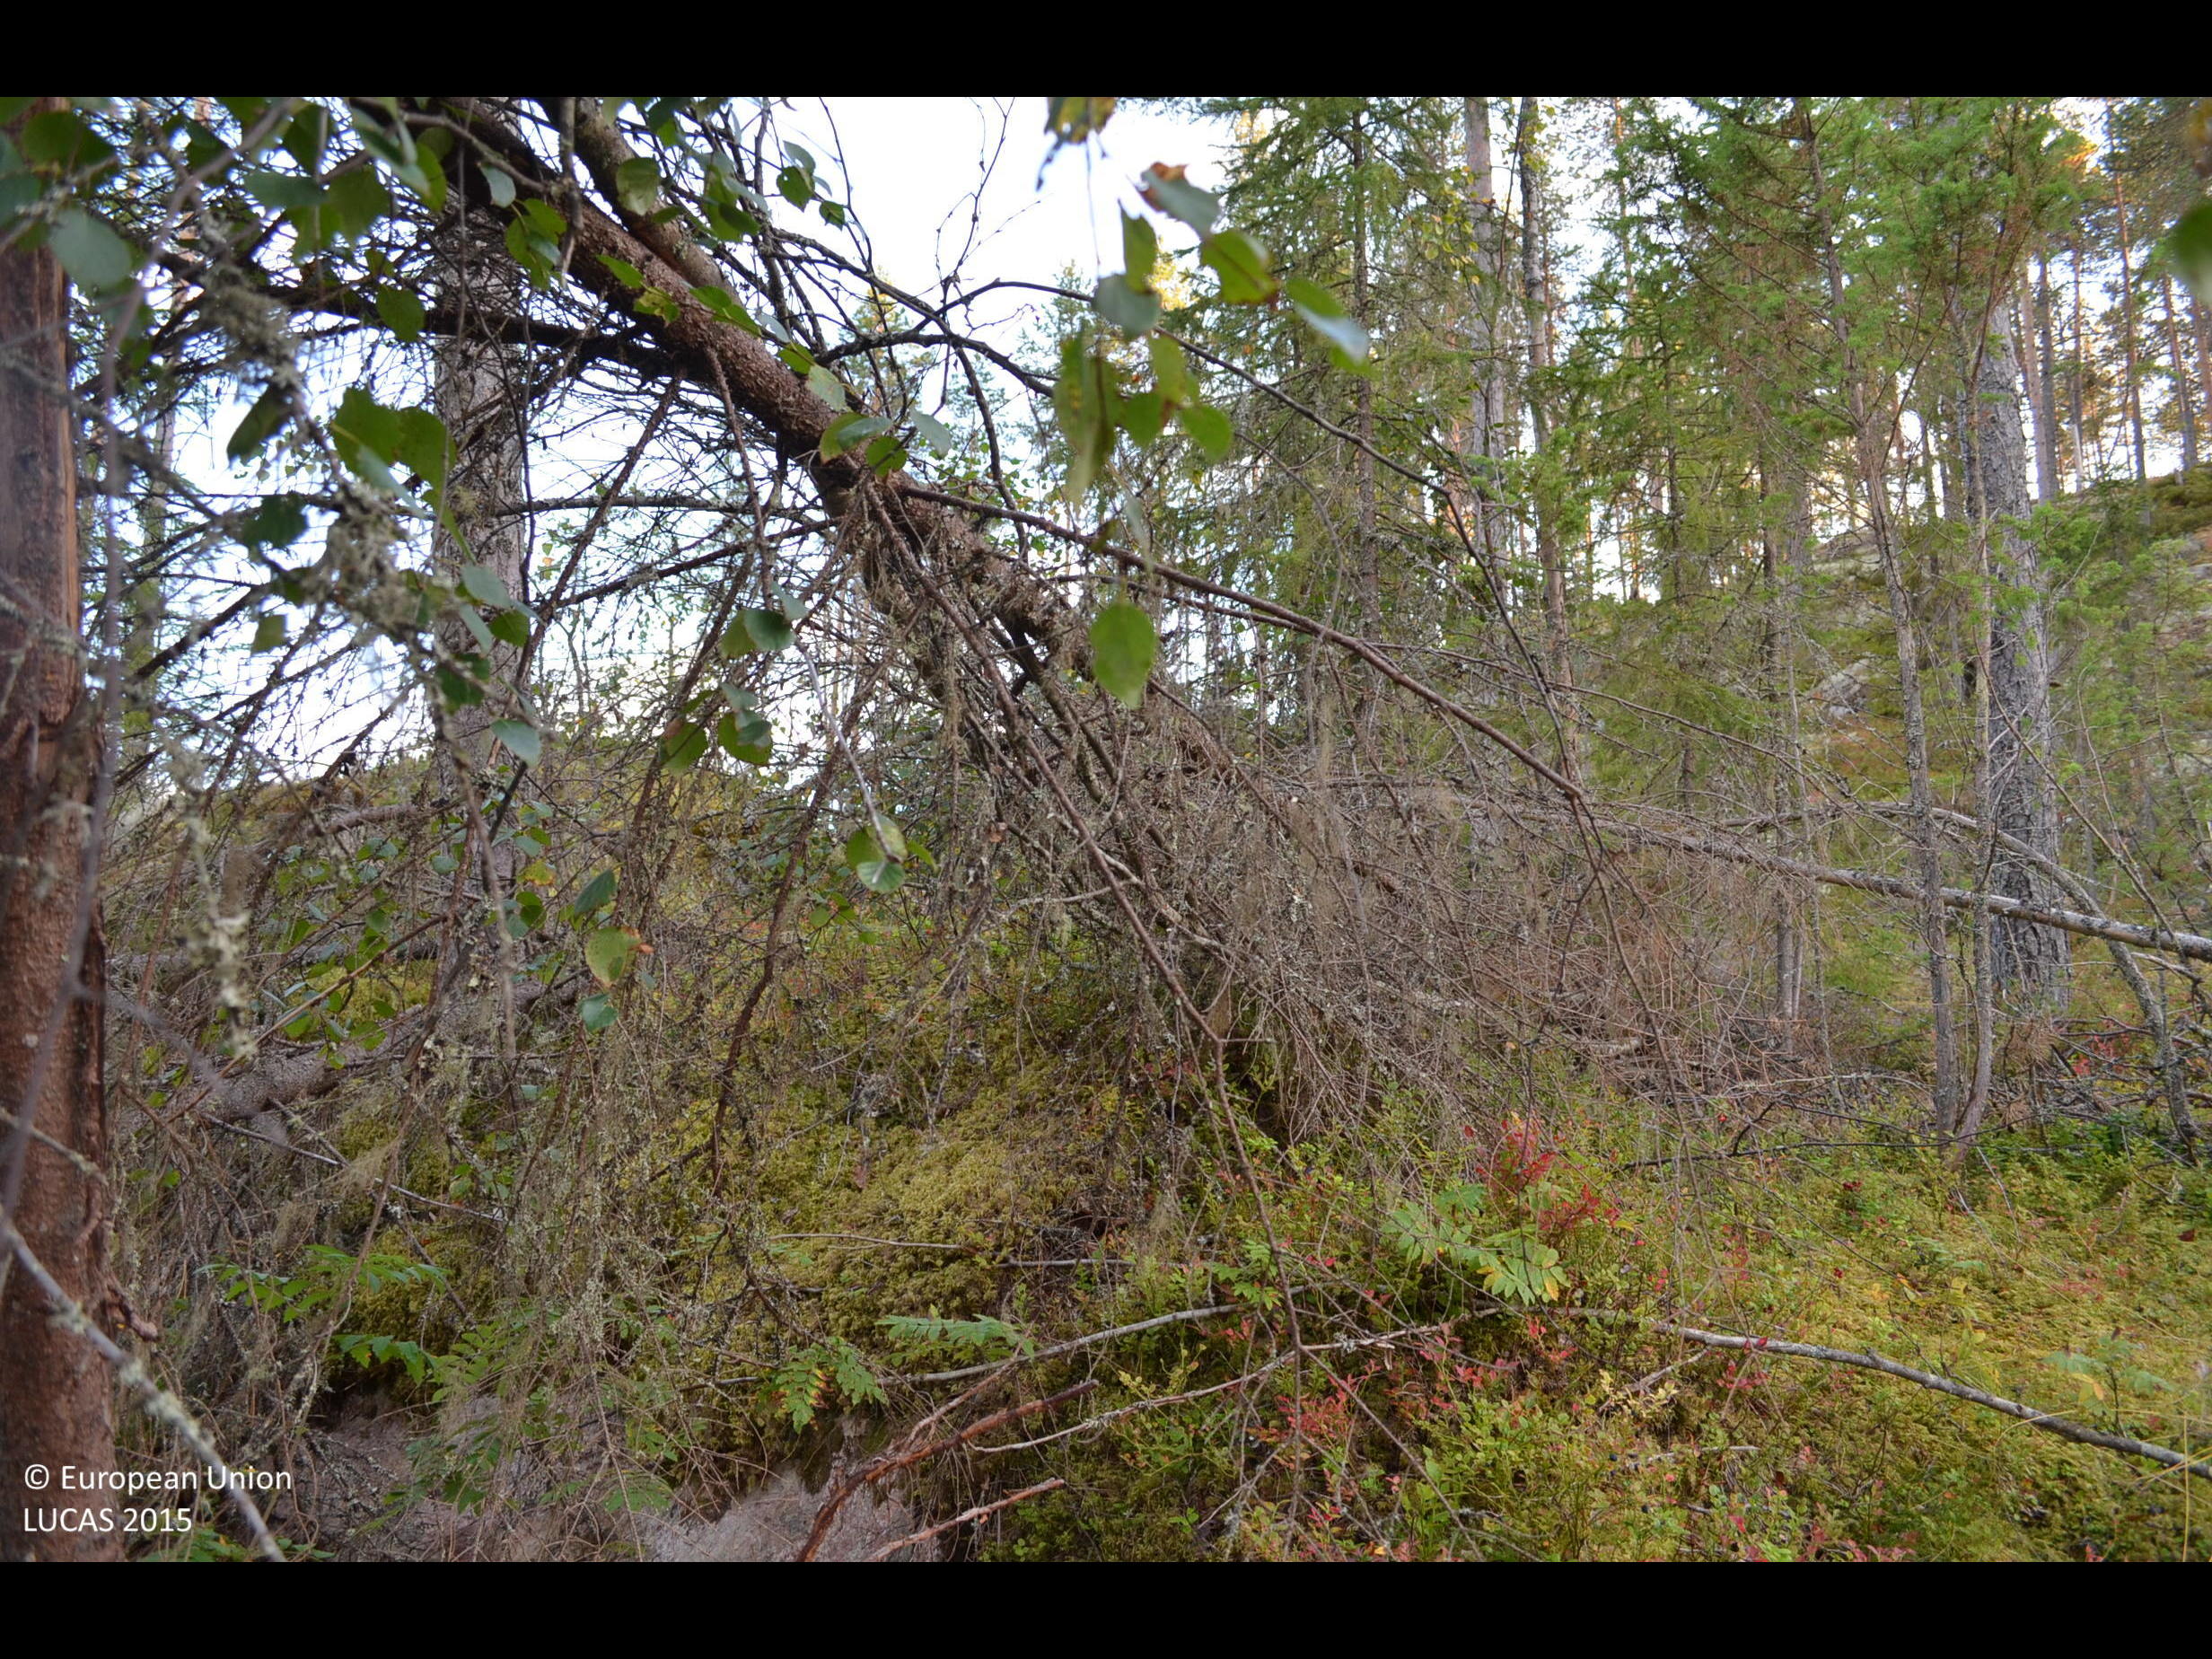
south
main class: Woodland
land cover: Other coniferous woodland
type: boreal forest
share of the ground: 50 - 75 %
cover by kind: coniferous forest trees 50 %, shrubs 30 %, broadleaved forest trees 10 %
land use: Forestry
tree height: > 5 m
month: August
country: FI
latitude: 62.4097
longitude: 23.6415
